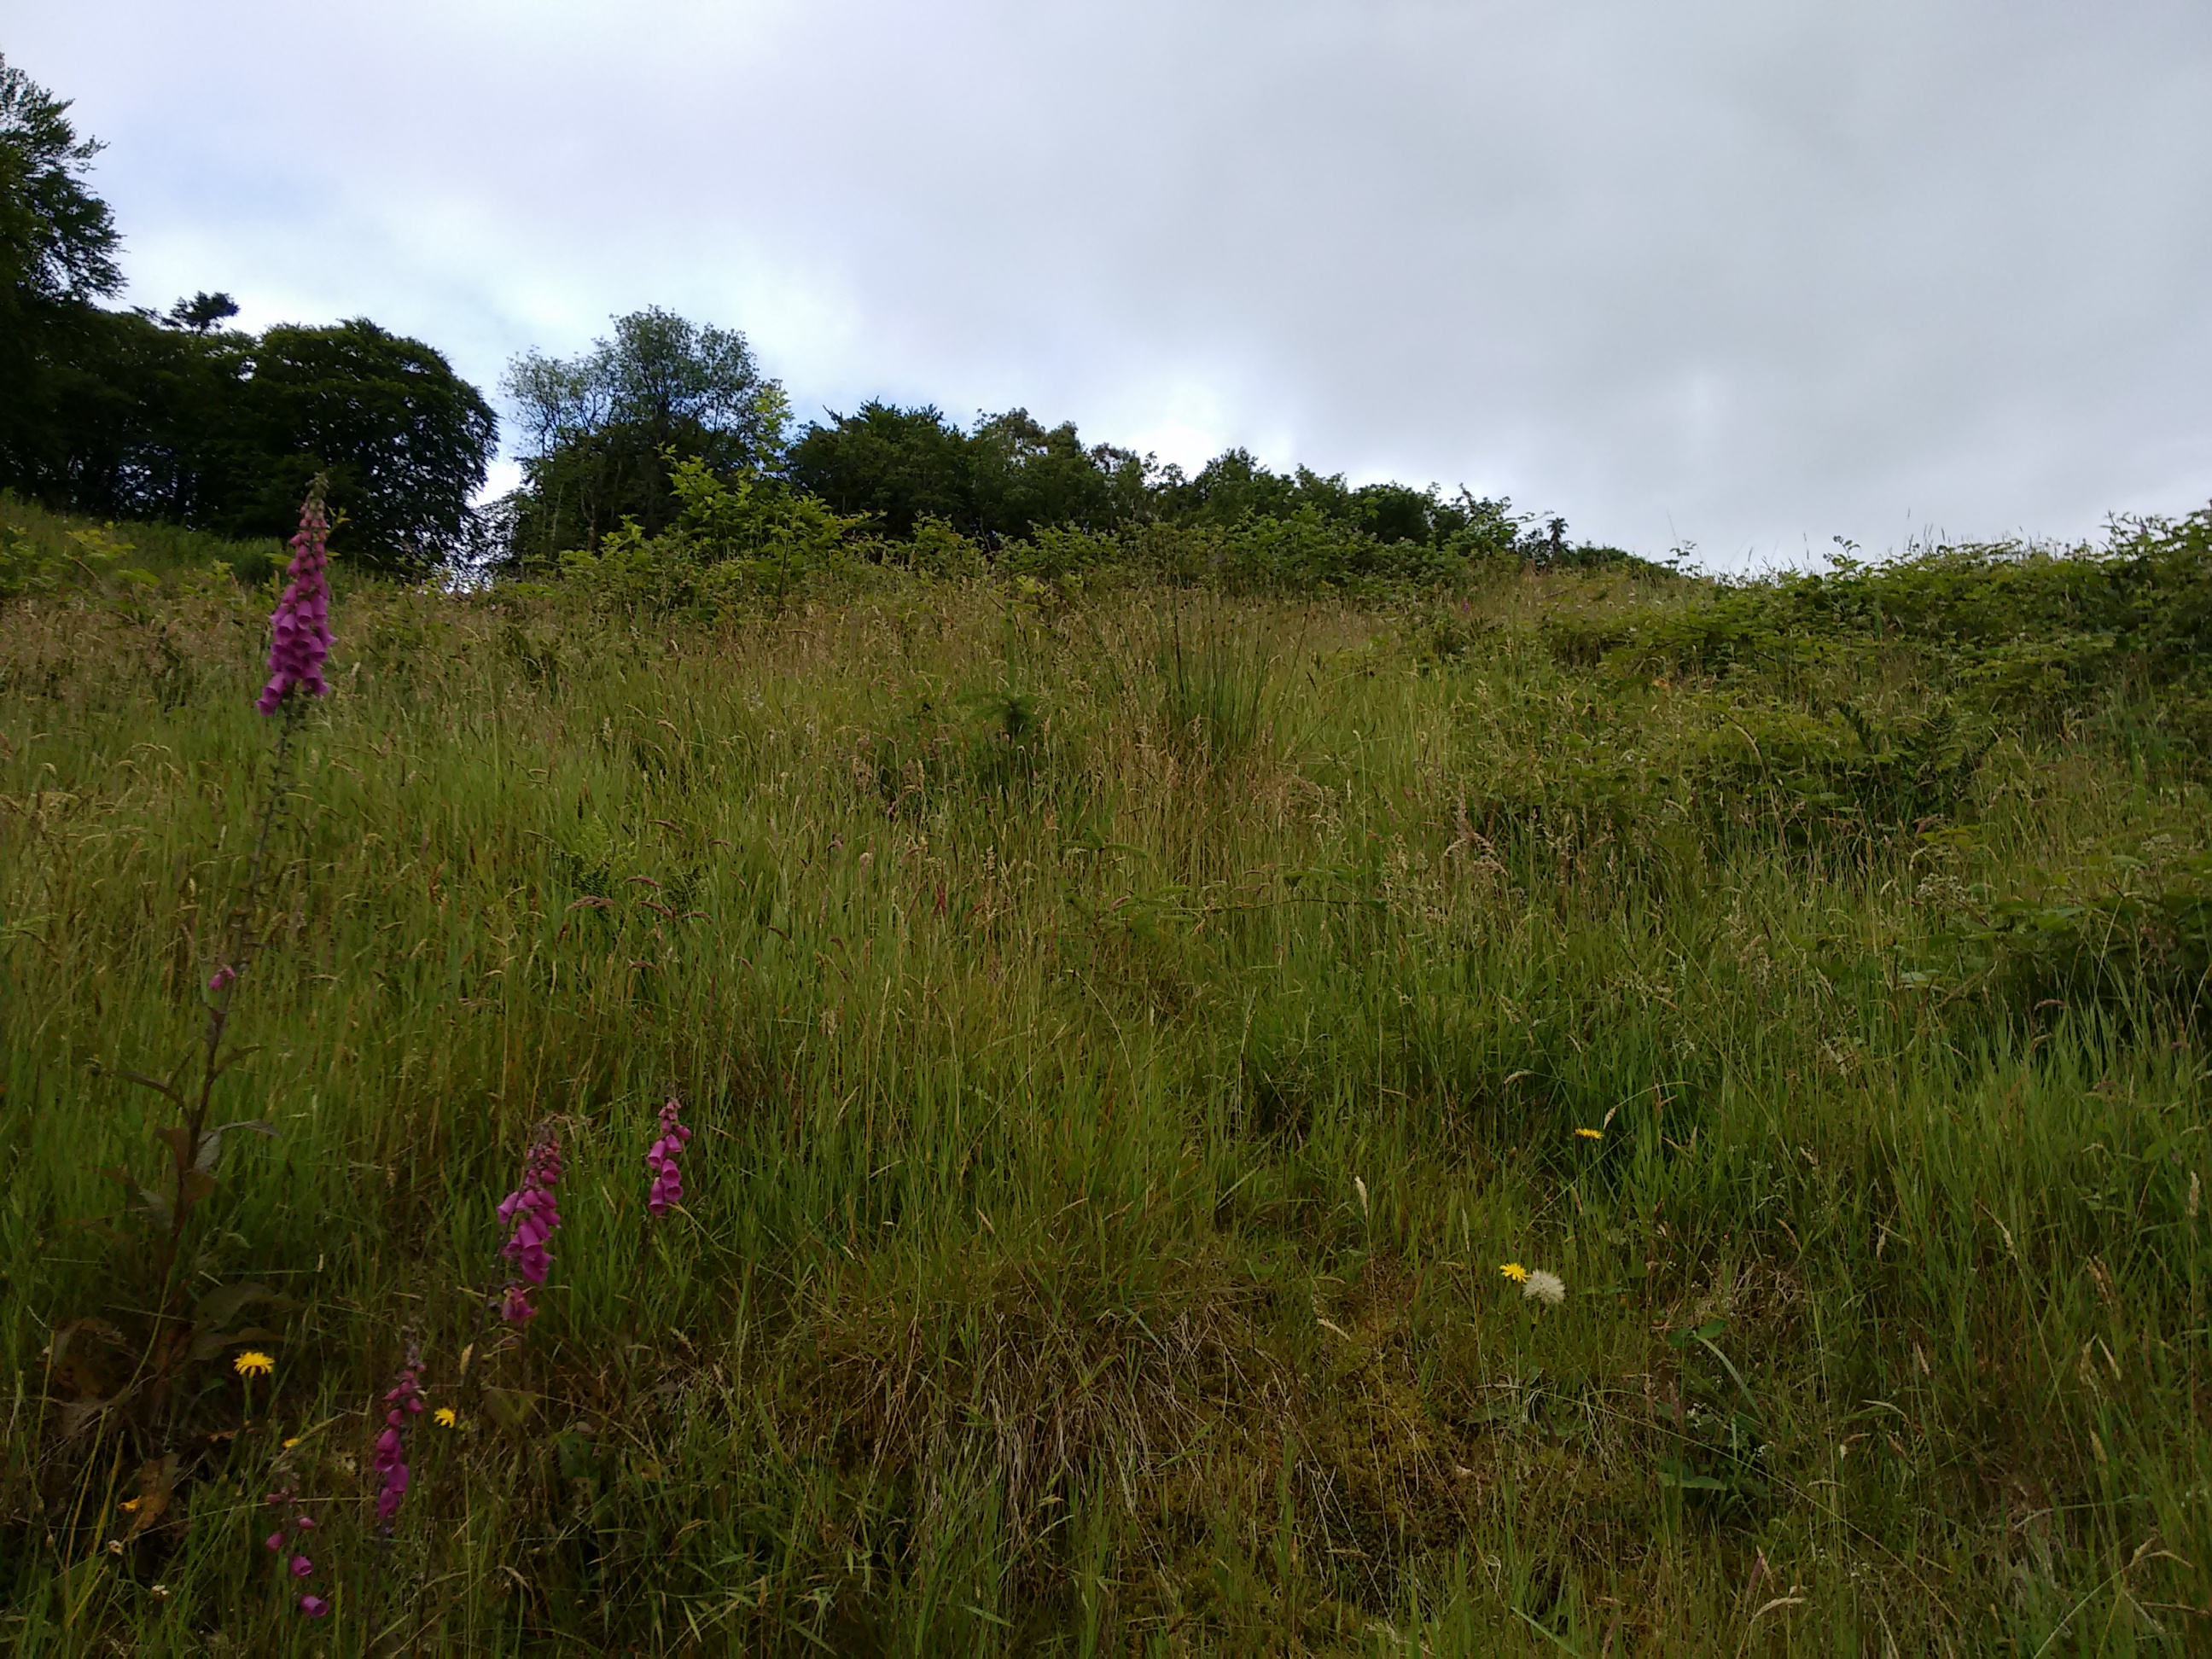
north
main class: Woodland
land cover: Other mixed woodland
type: hemiboreal forest and nemoral coniferous forest and mixed broadleaved-coniferous forest
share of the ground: > 75 %
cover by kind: coniferous forest trees 50 %, broadleaved forest trees 50 %
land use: Forestry
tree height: > 5 m
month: July
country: GB
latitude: 54.6474
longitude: -7.1762
